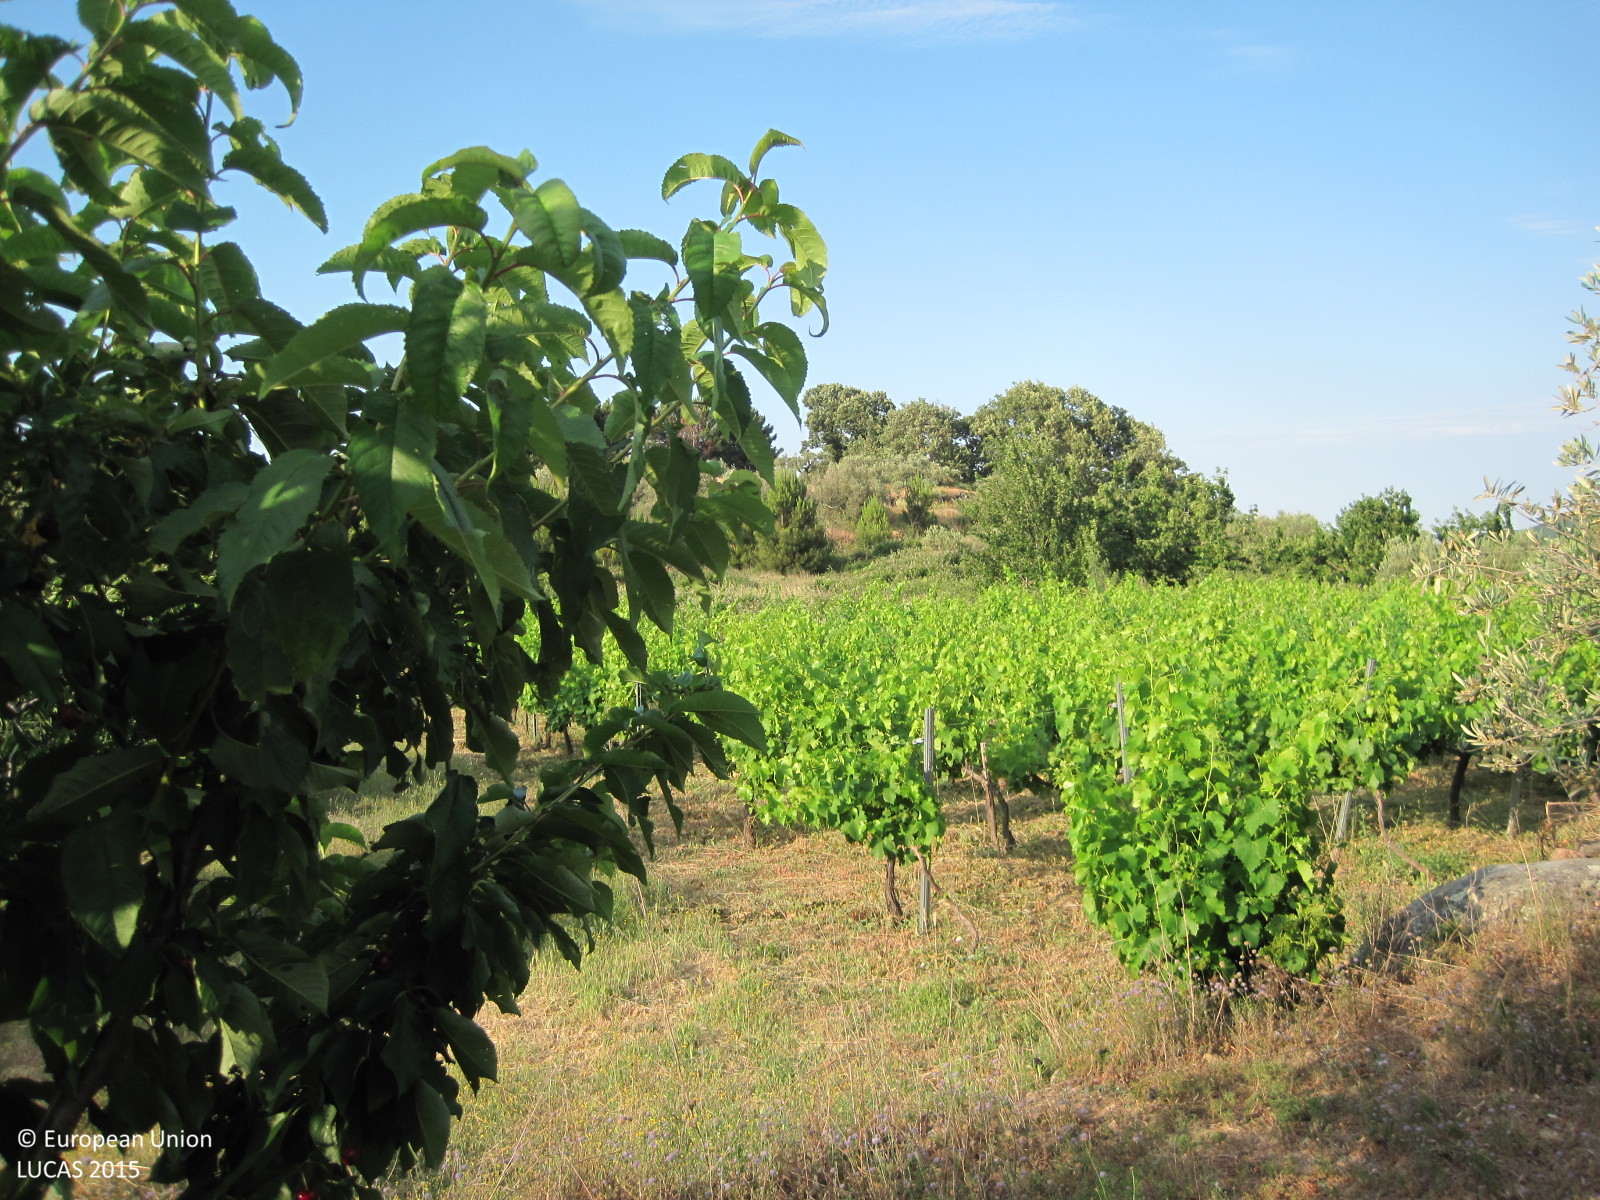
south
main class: Cropland
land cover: Vineyards
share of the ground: 25 - 50 %
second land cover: Nuts trees
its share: 25 - 50 %
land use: Agriculture (excluding fallow land and kitchen gardens)
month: June
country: ES
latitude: 40.2814
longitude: -5.0044
